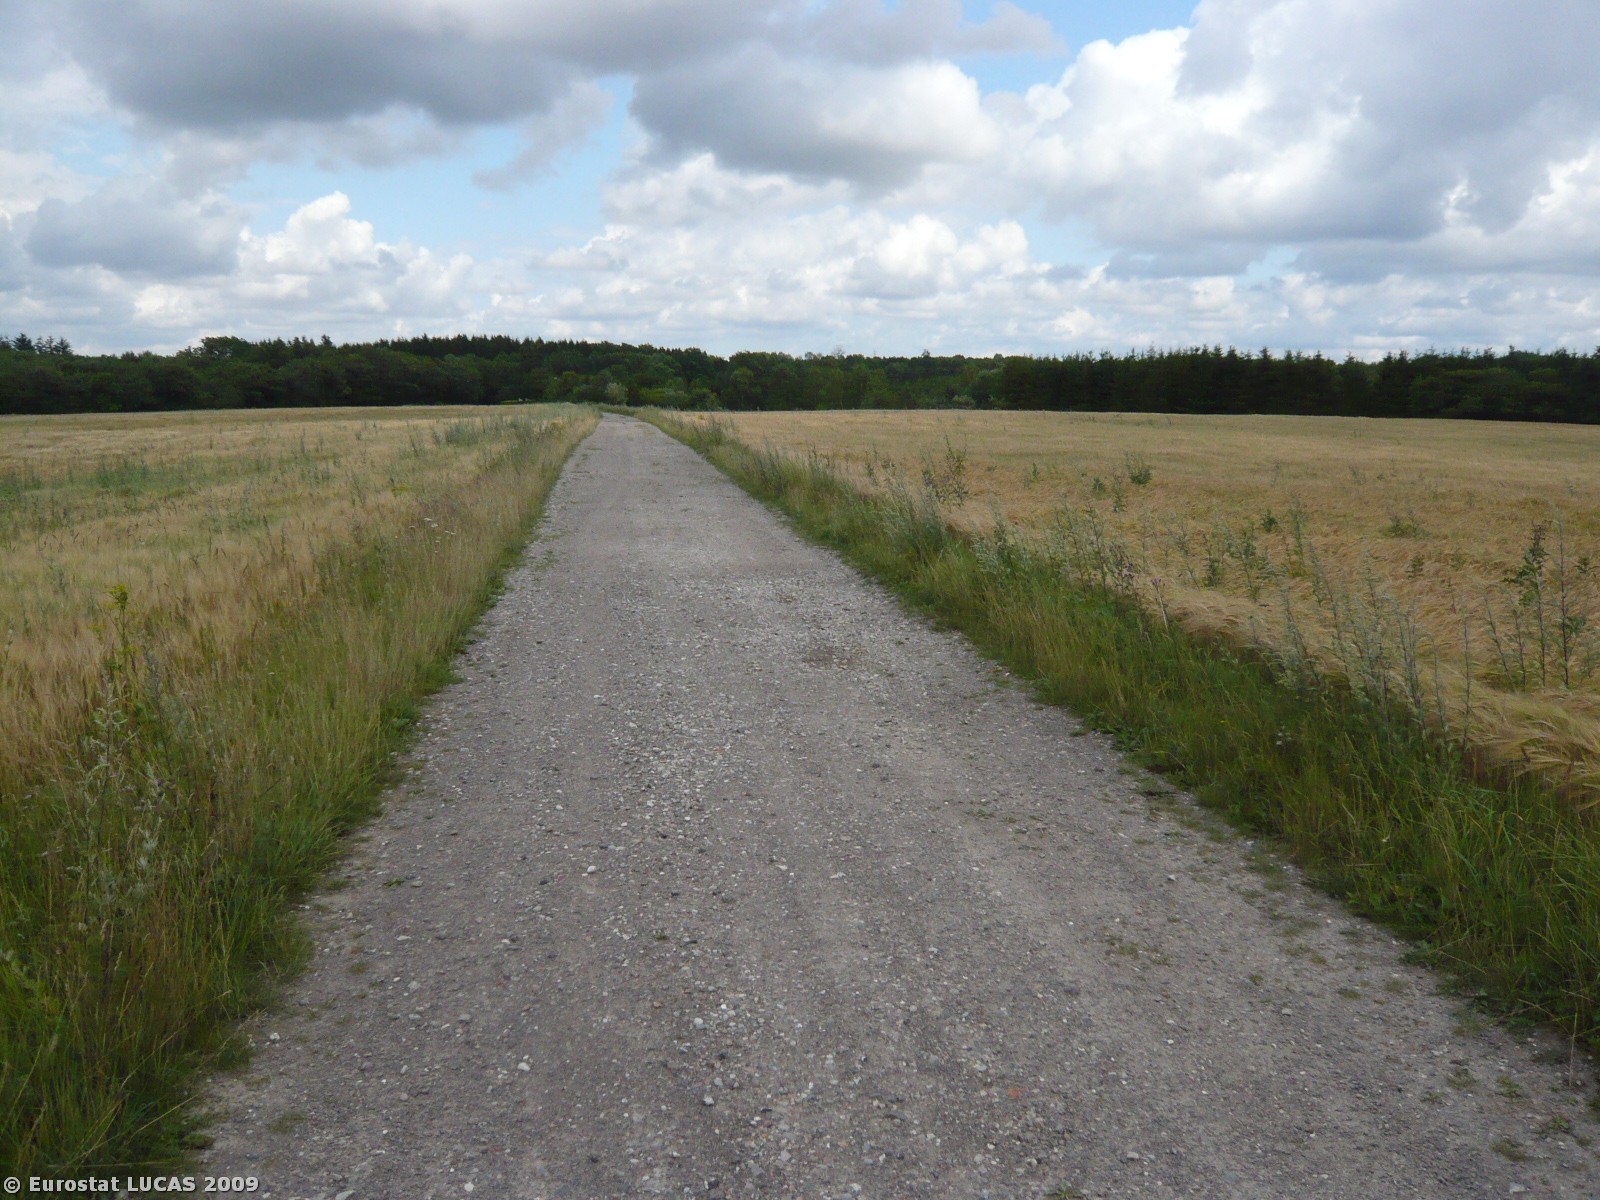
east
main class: Cropland
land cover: Barley
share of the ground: > 75 %
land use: Agriculture (excluding fallow land and kitchen gardens)
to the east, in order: Barley; Coniferous woodland; Shrubland with sparse tree cover; Broadleaved woodland; Inland marshes; Inland water bodies
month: July
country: DK
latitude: 55.5082
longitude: 11.9143
